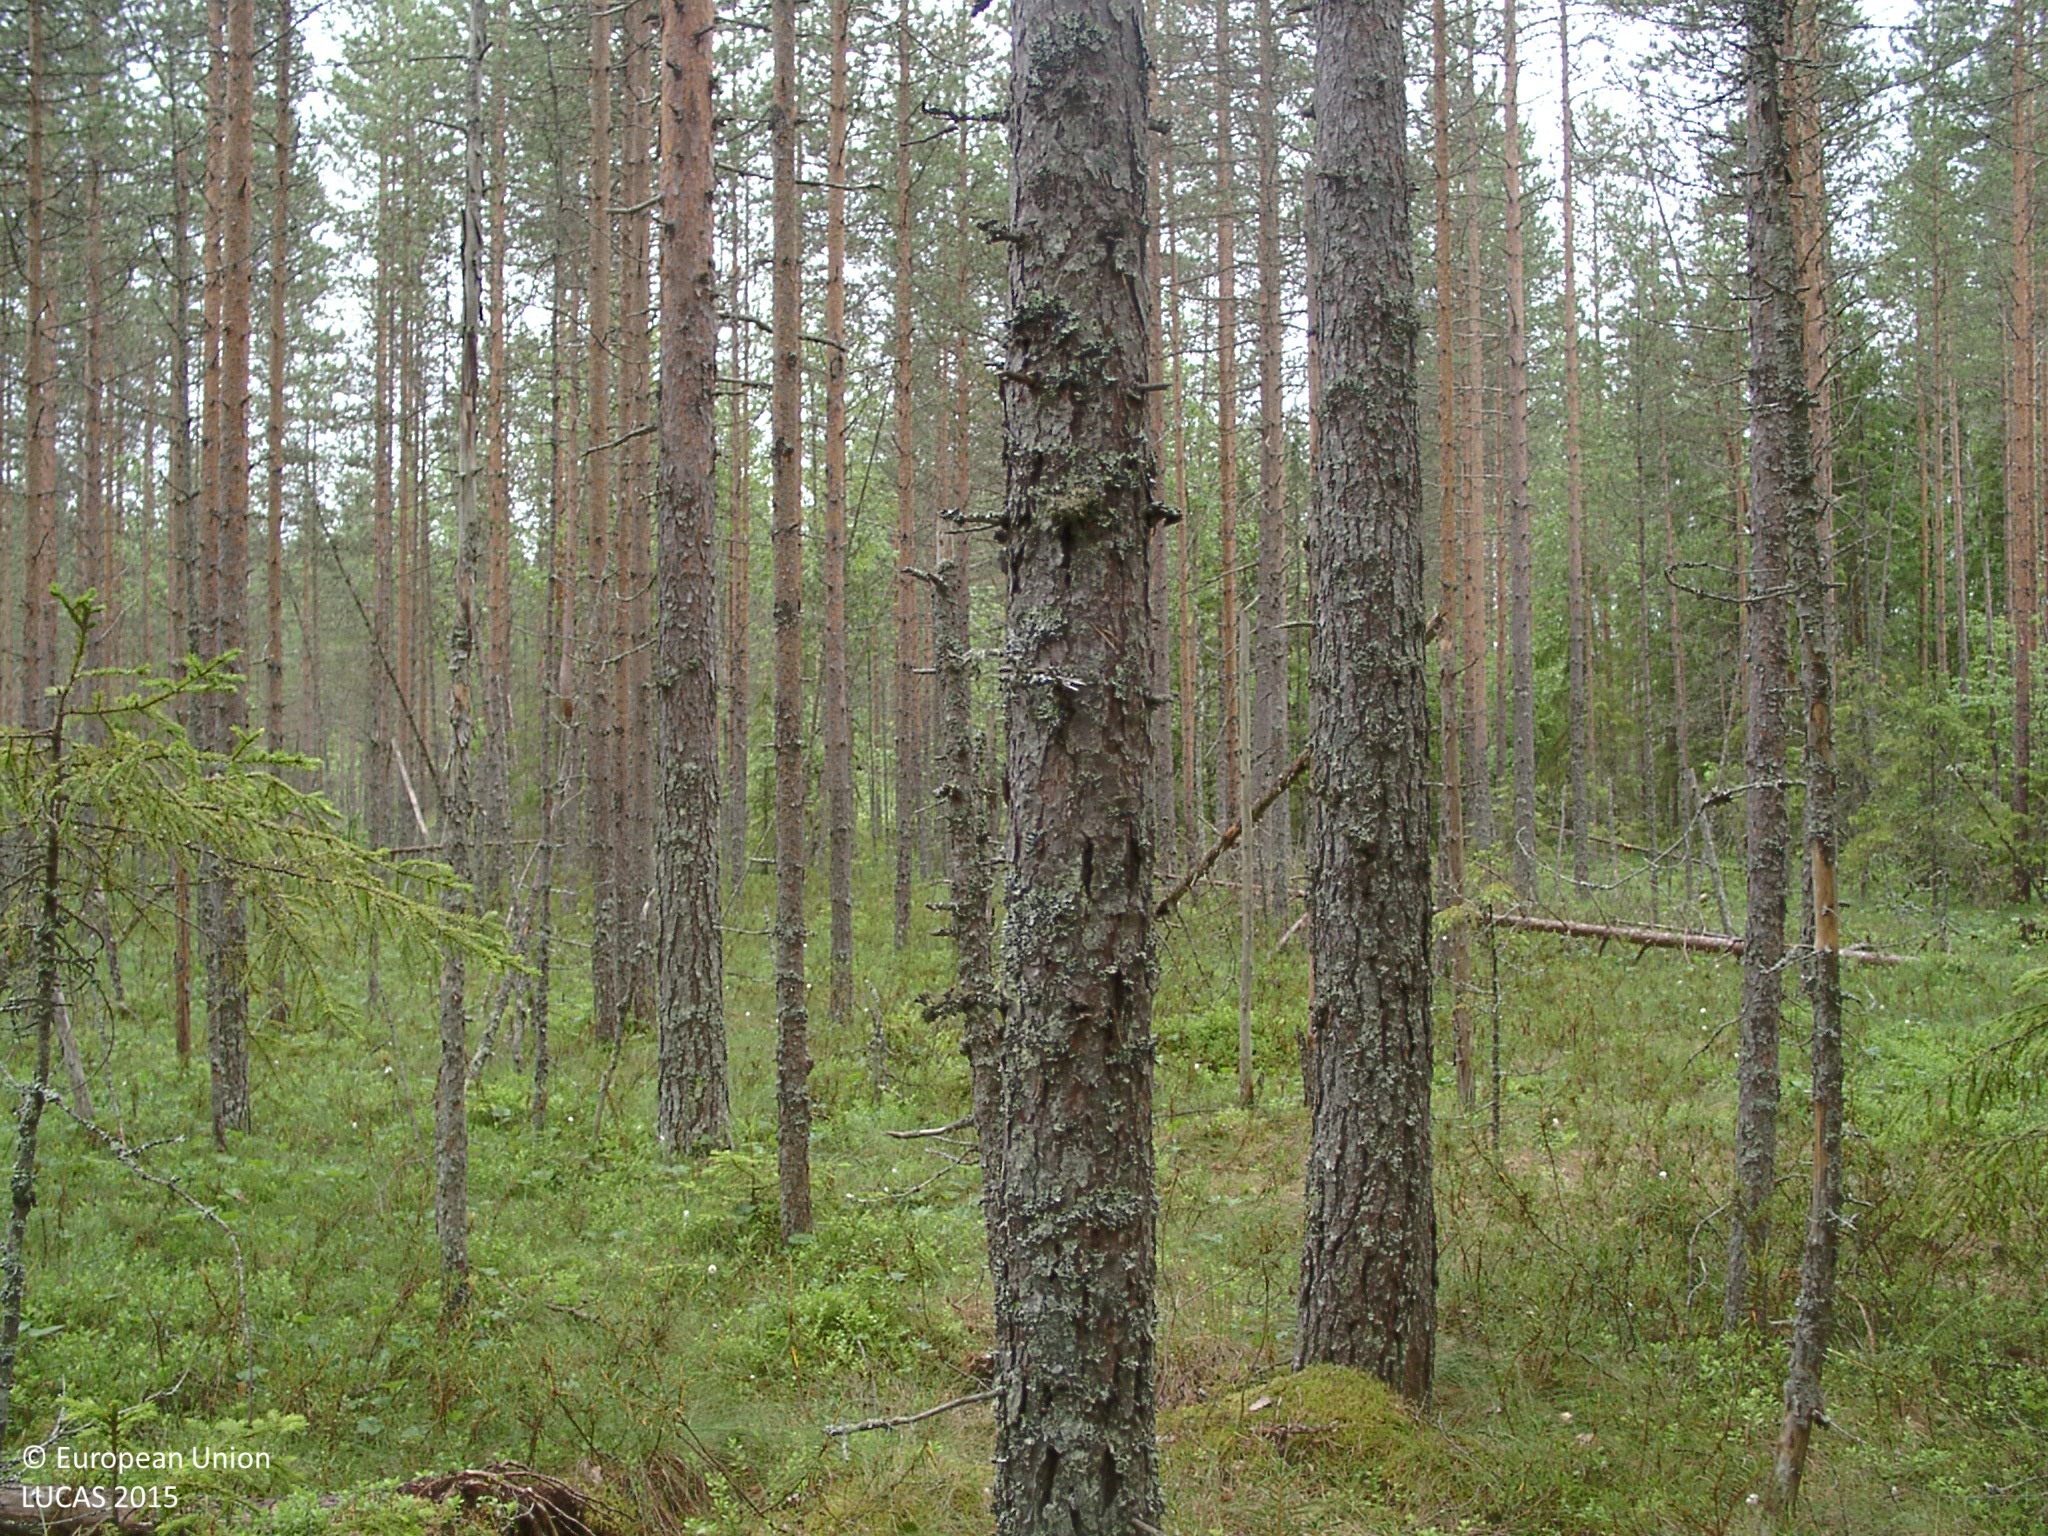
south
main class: Woodland
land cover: Other mixed woodland
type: boreal forest
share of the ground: > 75 %
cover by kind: coniferous forest trees 50 %, broadleaved forest trees 25 %, shrubs 10 %, lichens and mosses 10 %, herbaceous plants 5 %
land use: Semi-natural and natural areas not in use
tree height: > 5 m
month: July
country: FI
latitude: 62.1484
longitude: 25.3658
